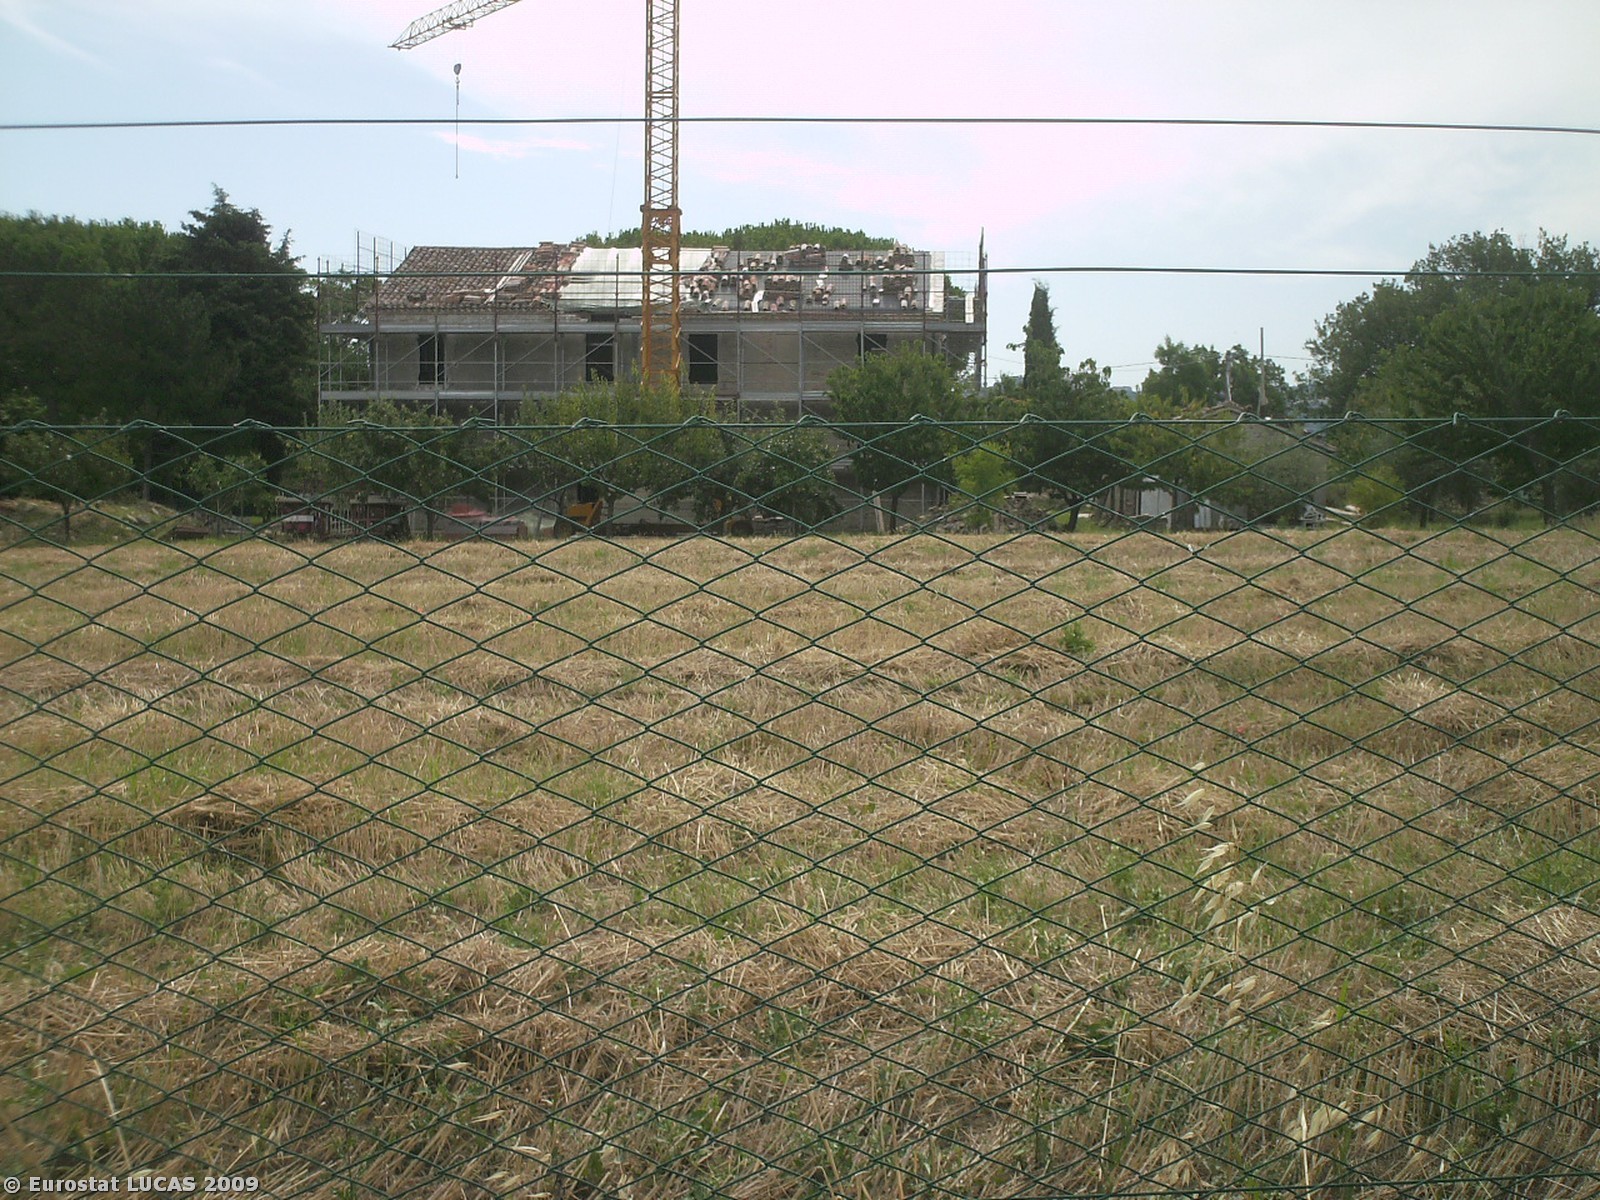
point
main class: Grassland
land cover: Grassland without tree/shrub cover
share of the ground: > 75 %
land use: Agriculture (excluding fallow land and kitchen gardens)
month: July
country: IT
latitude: 43.7502
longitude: 12.9115
